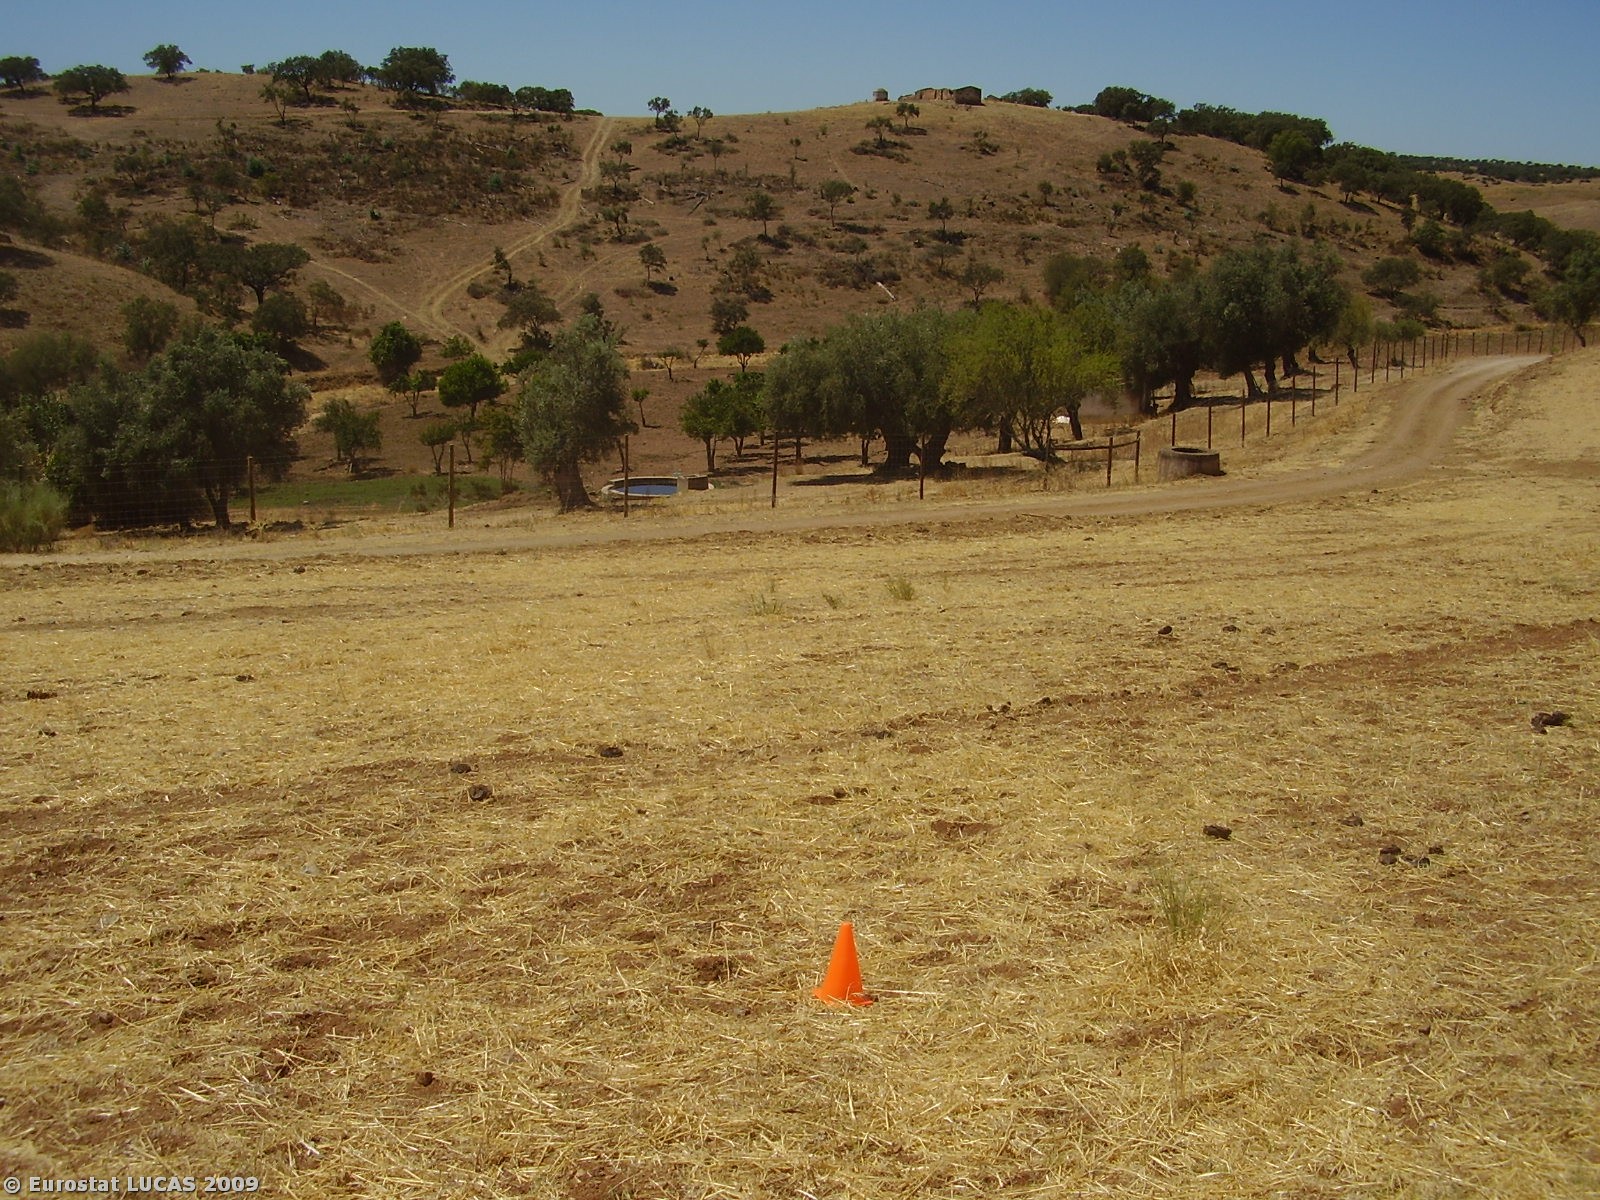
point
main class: Cropland
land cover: Common wheat
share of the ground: < 10 %
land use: Agriculture (excluding fallow land and kitchen gardens)
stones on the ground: 25 - 50 %
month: August
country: PT
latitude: 37.9113
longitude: -7.6625
